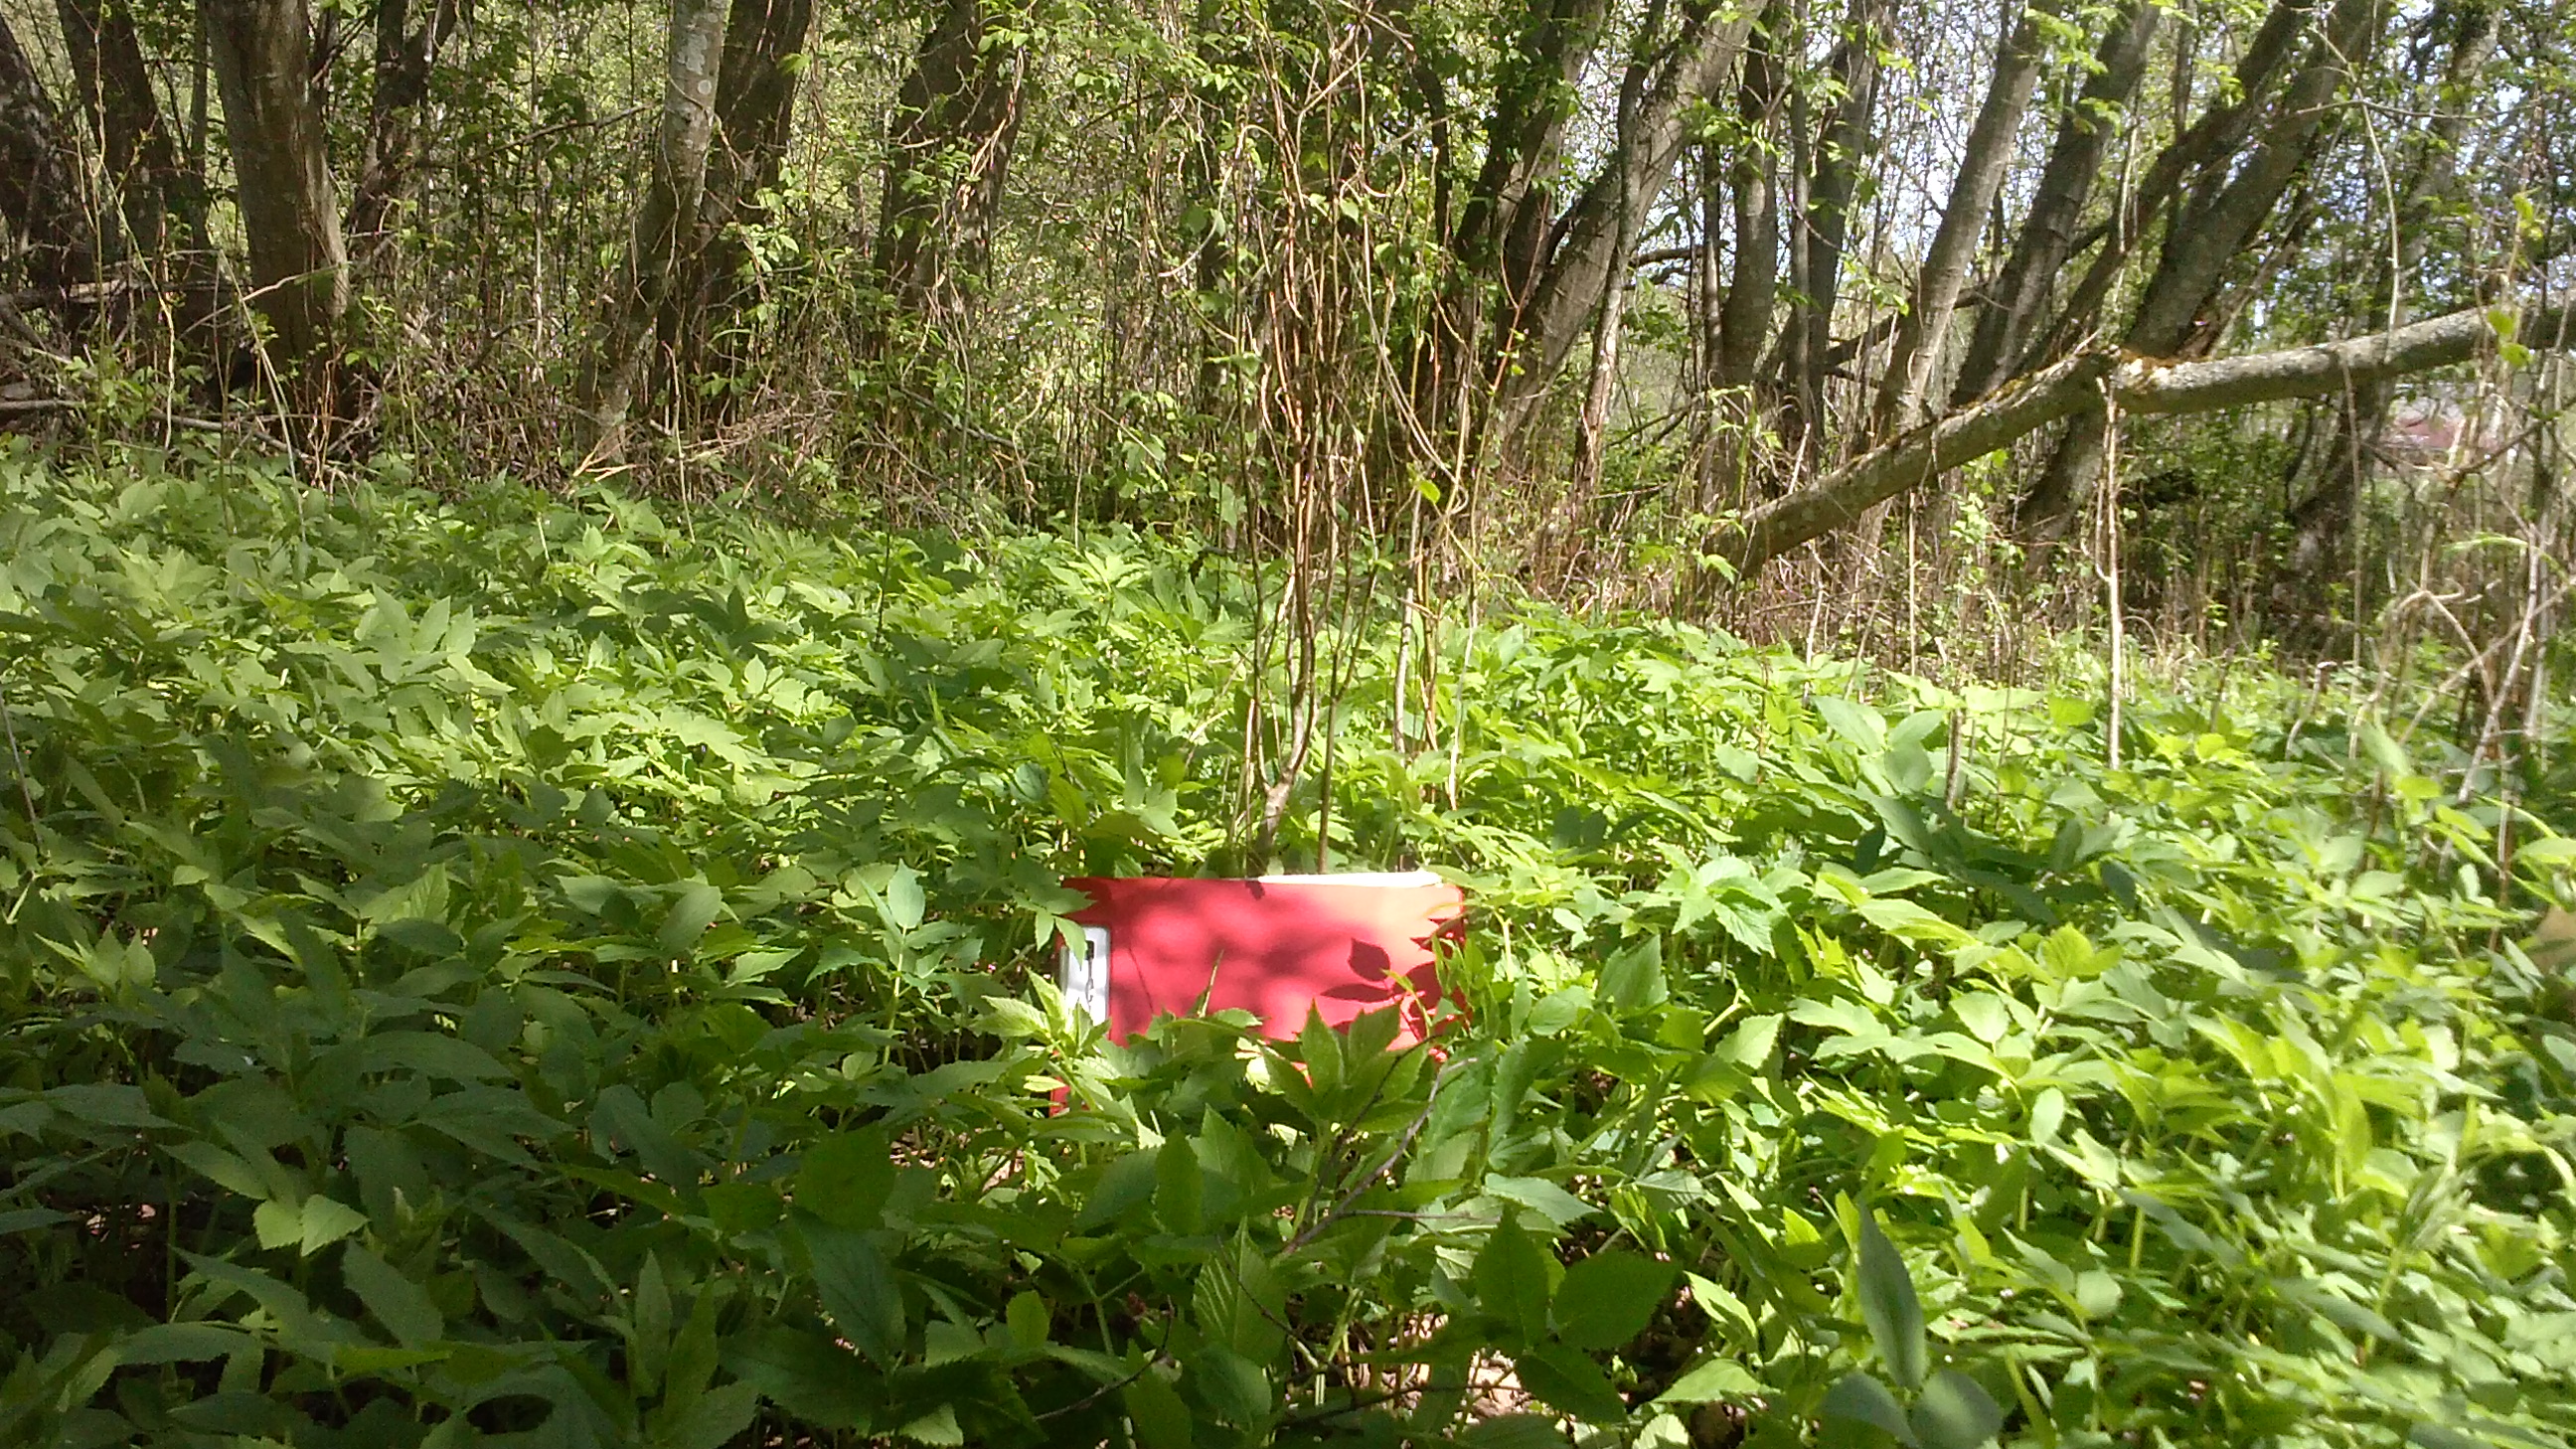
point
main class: Woodland
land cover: Broadleaved woodland
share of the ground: > 75 %
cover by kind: broadleaved forest trees 100 %
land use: Semi-natural and natural areas not in use
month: May
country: LV
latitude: 55.8929
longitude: 27.2352
